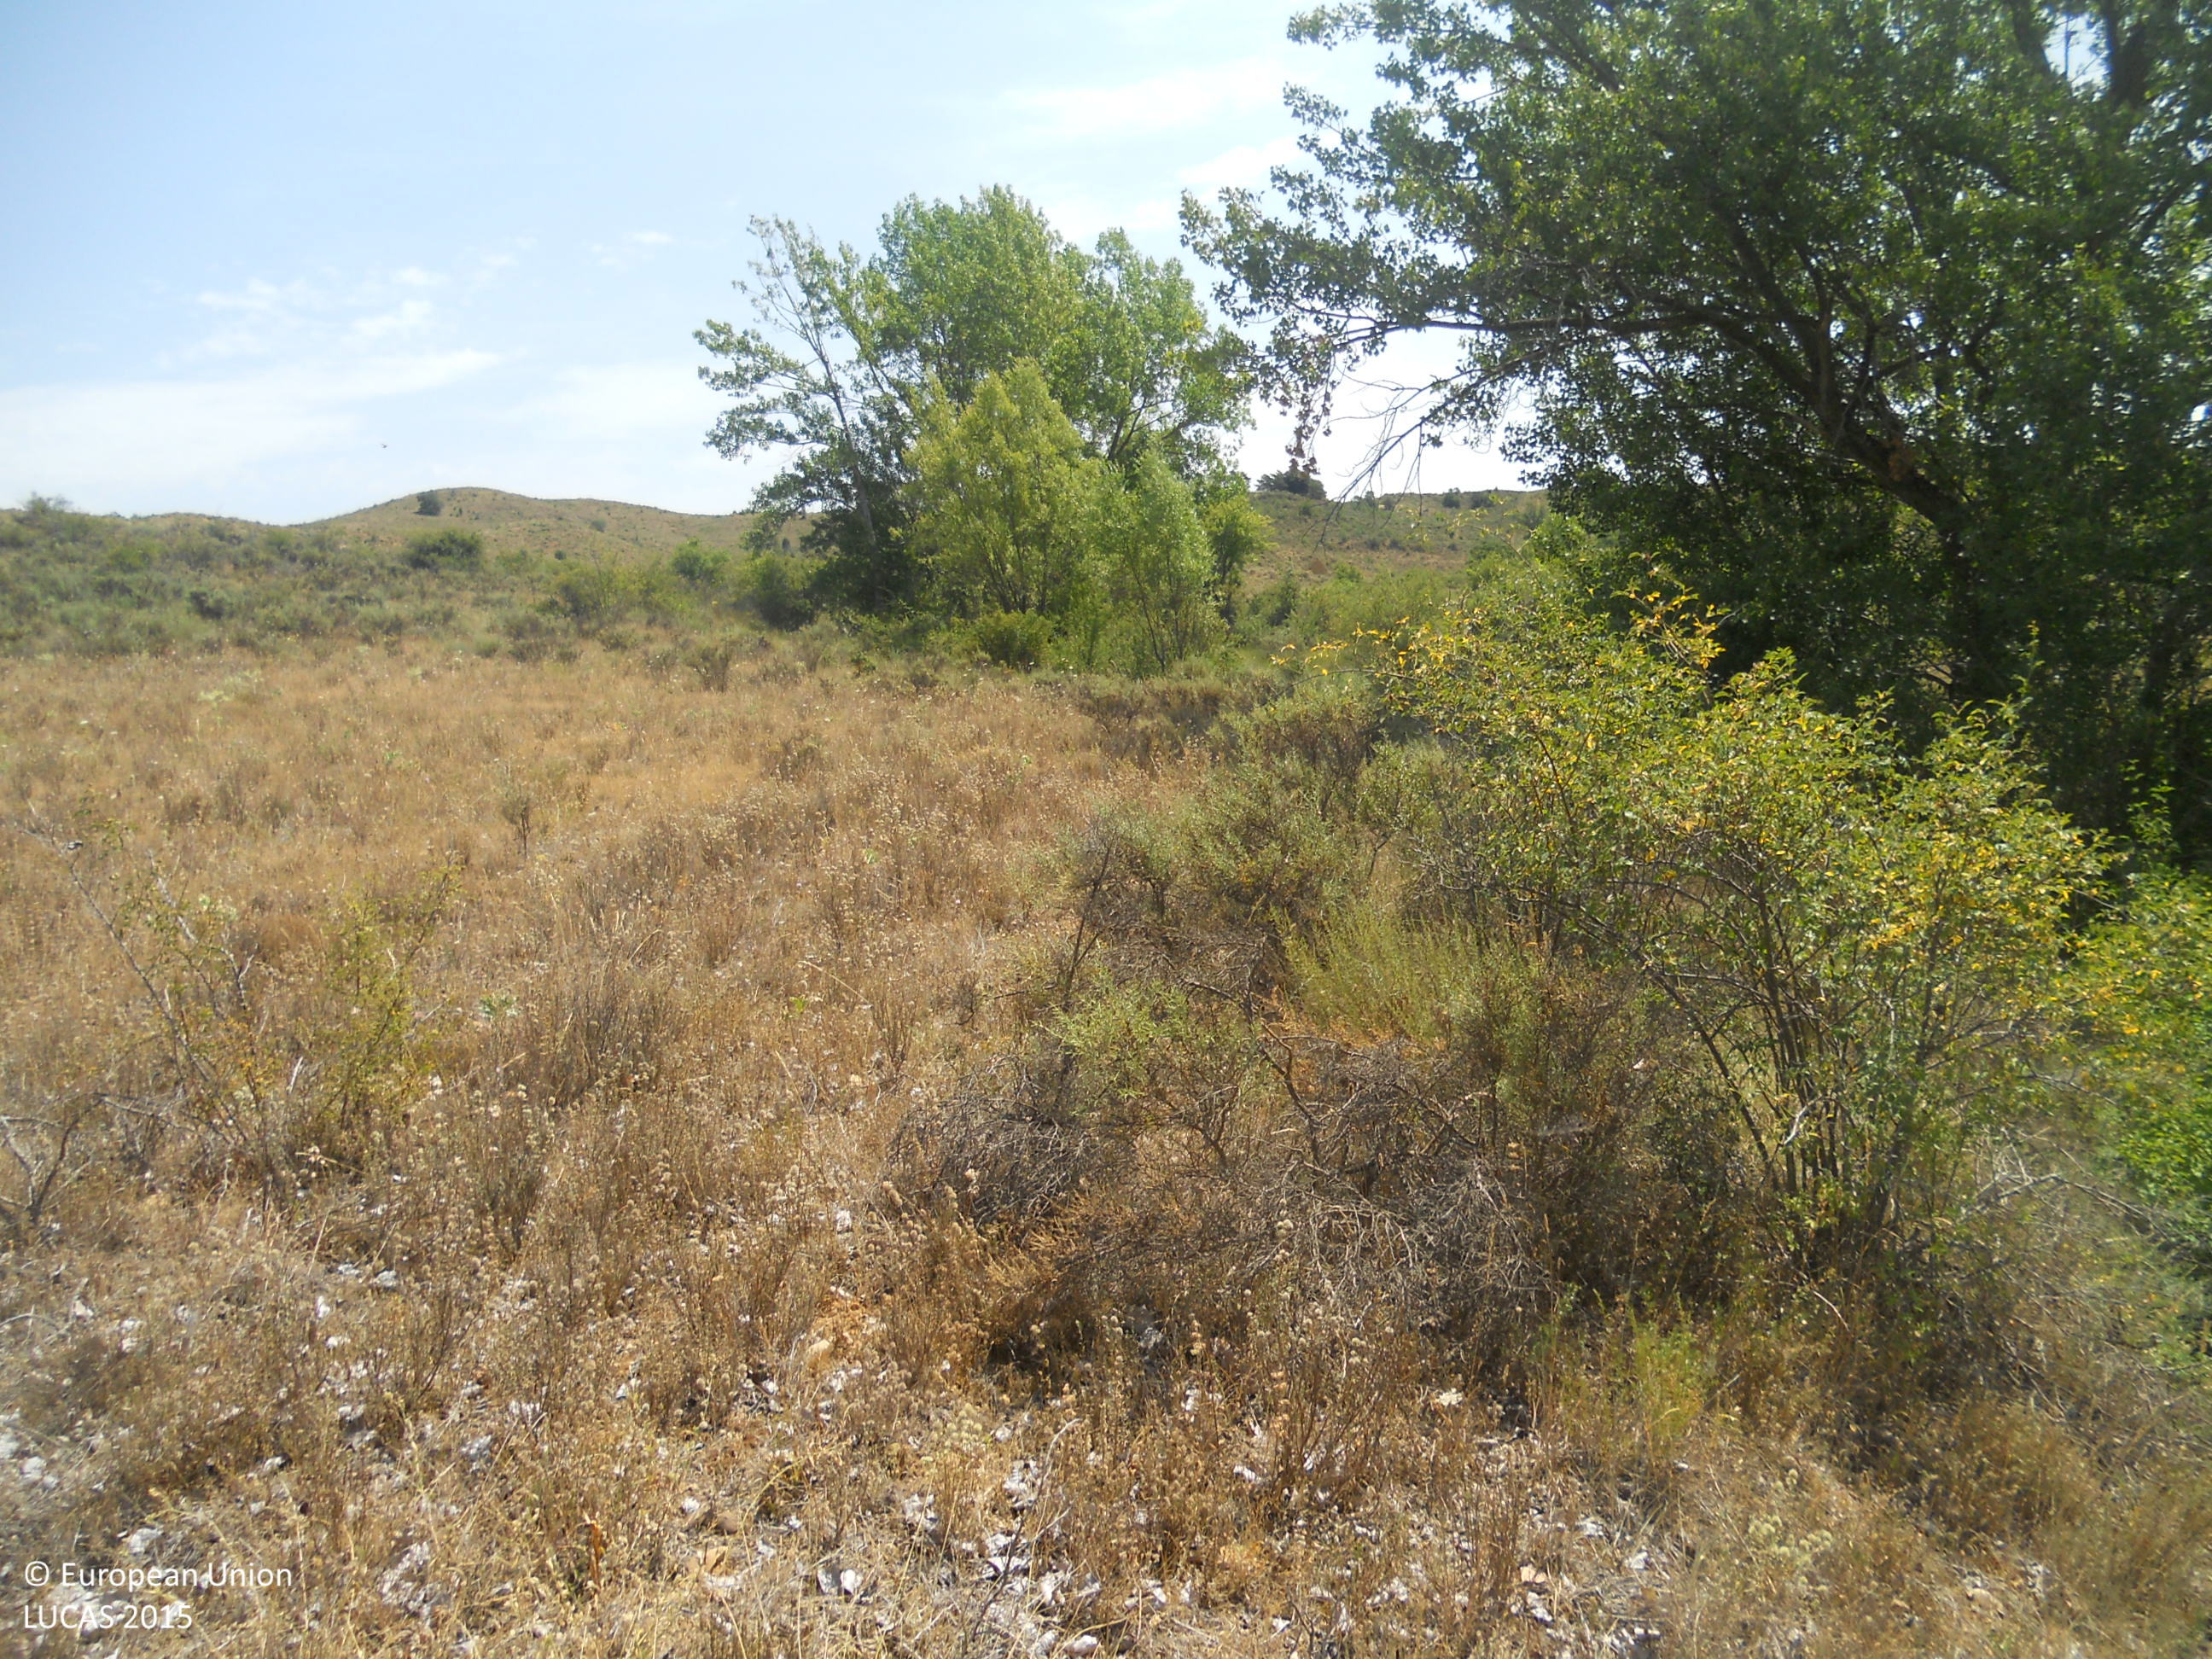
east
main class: Shrubland
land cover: Shrubland without tree cover
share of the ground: > 75 %
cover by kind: shrubs 60 %, herbaceous plants 40 %
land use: Semi-natural and natural areas not in use
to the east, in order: Shrubland without tree cover; Tracks; Shrubland without tree cover
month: July
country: ES
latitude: 42.6284
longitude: -5.3719
